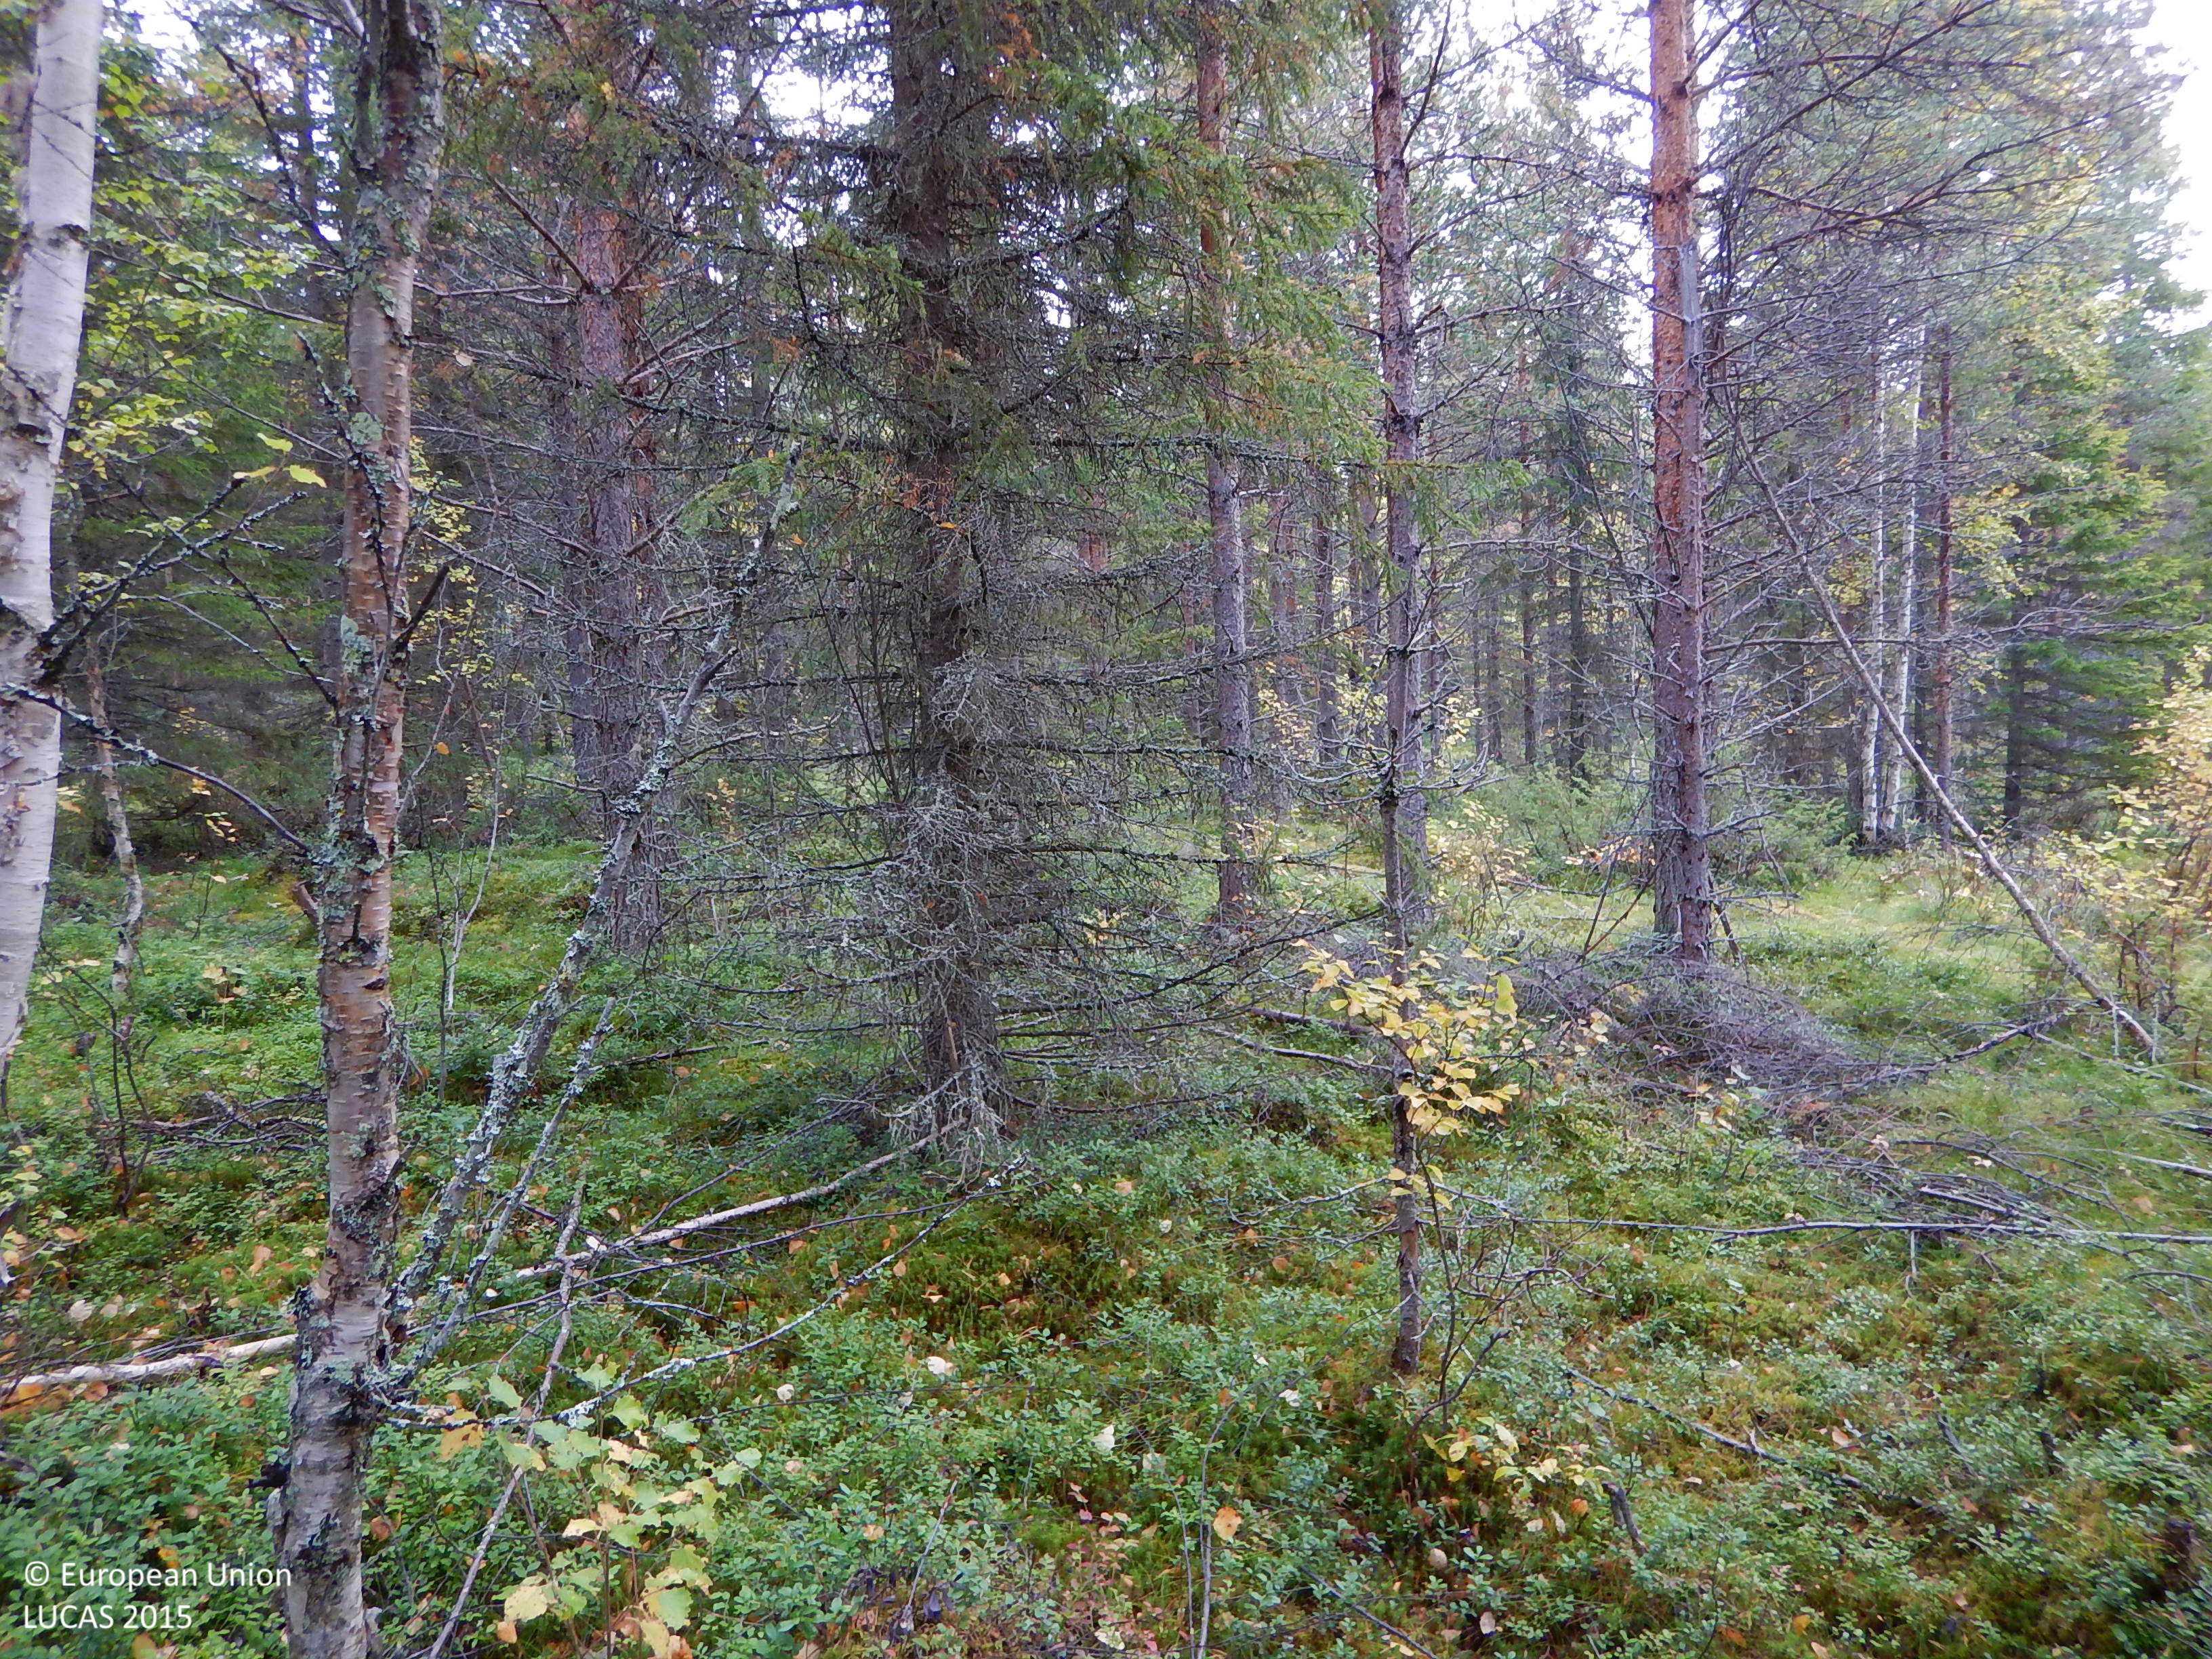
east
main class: Woodland
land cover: Other coniferous woodland
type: boreal forest
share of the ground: 50 - 75 %
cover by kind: coniferous forest trees 60 %, shrubs 15 %, herbaceous plants 10 %, lichens and mosses 10 %, broadleaved forest trees 5 %
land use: Forestry
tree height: > 5 m
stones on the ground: < 10 %
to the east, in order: Other coniferous woodland; Pine dominated coniferous woodland; Tracks; Pine dominated mixed woodland; Pine dominated coniferous woodland
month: September
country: SE
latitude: 64.8001
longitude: 19.8850
